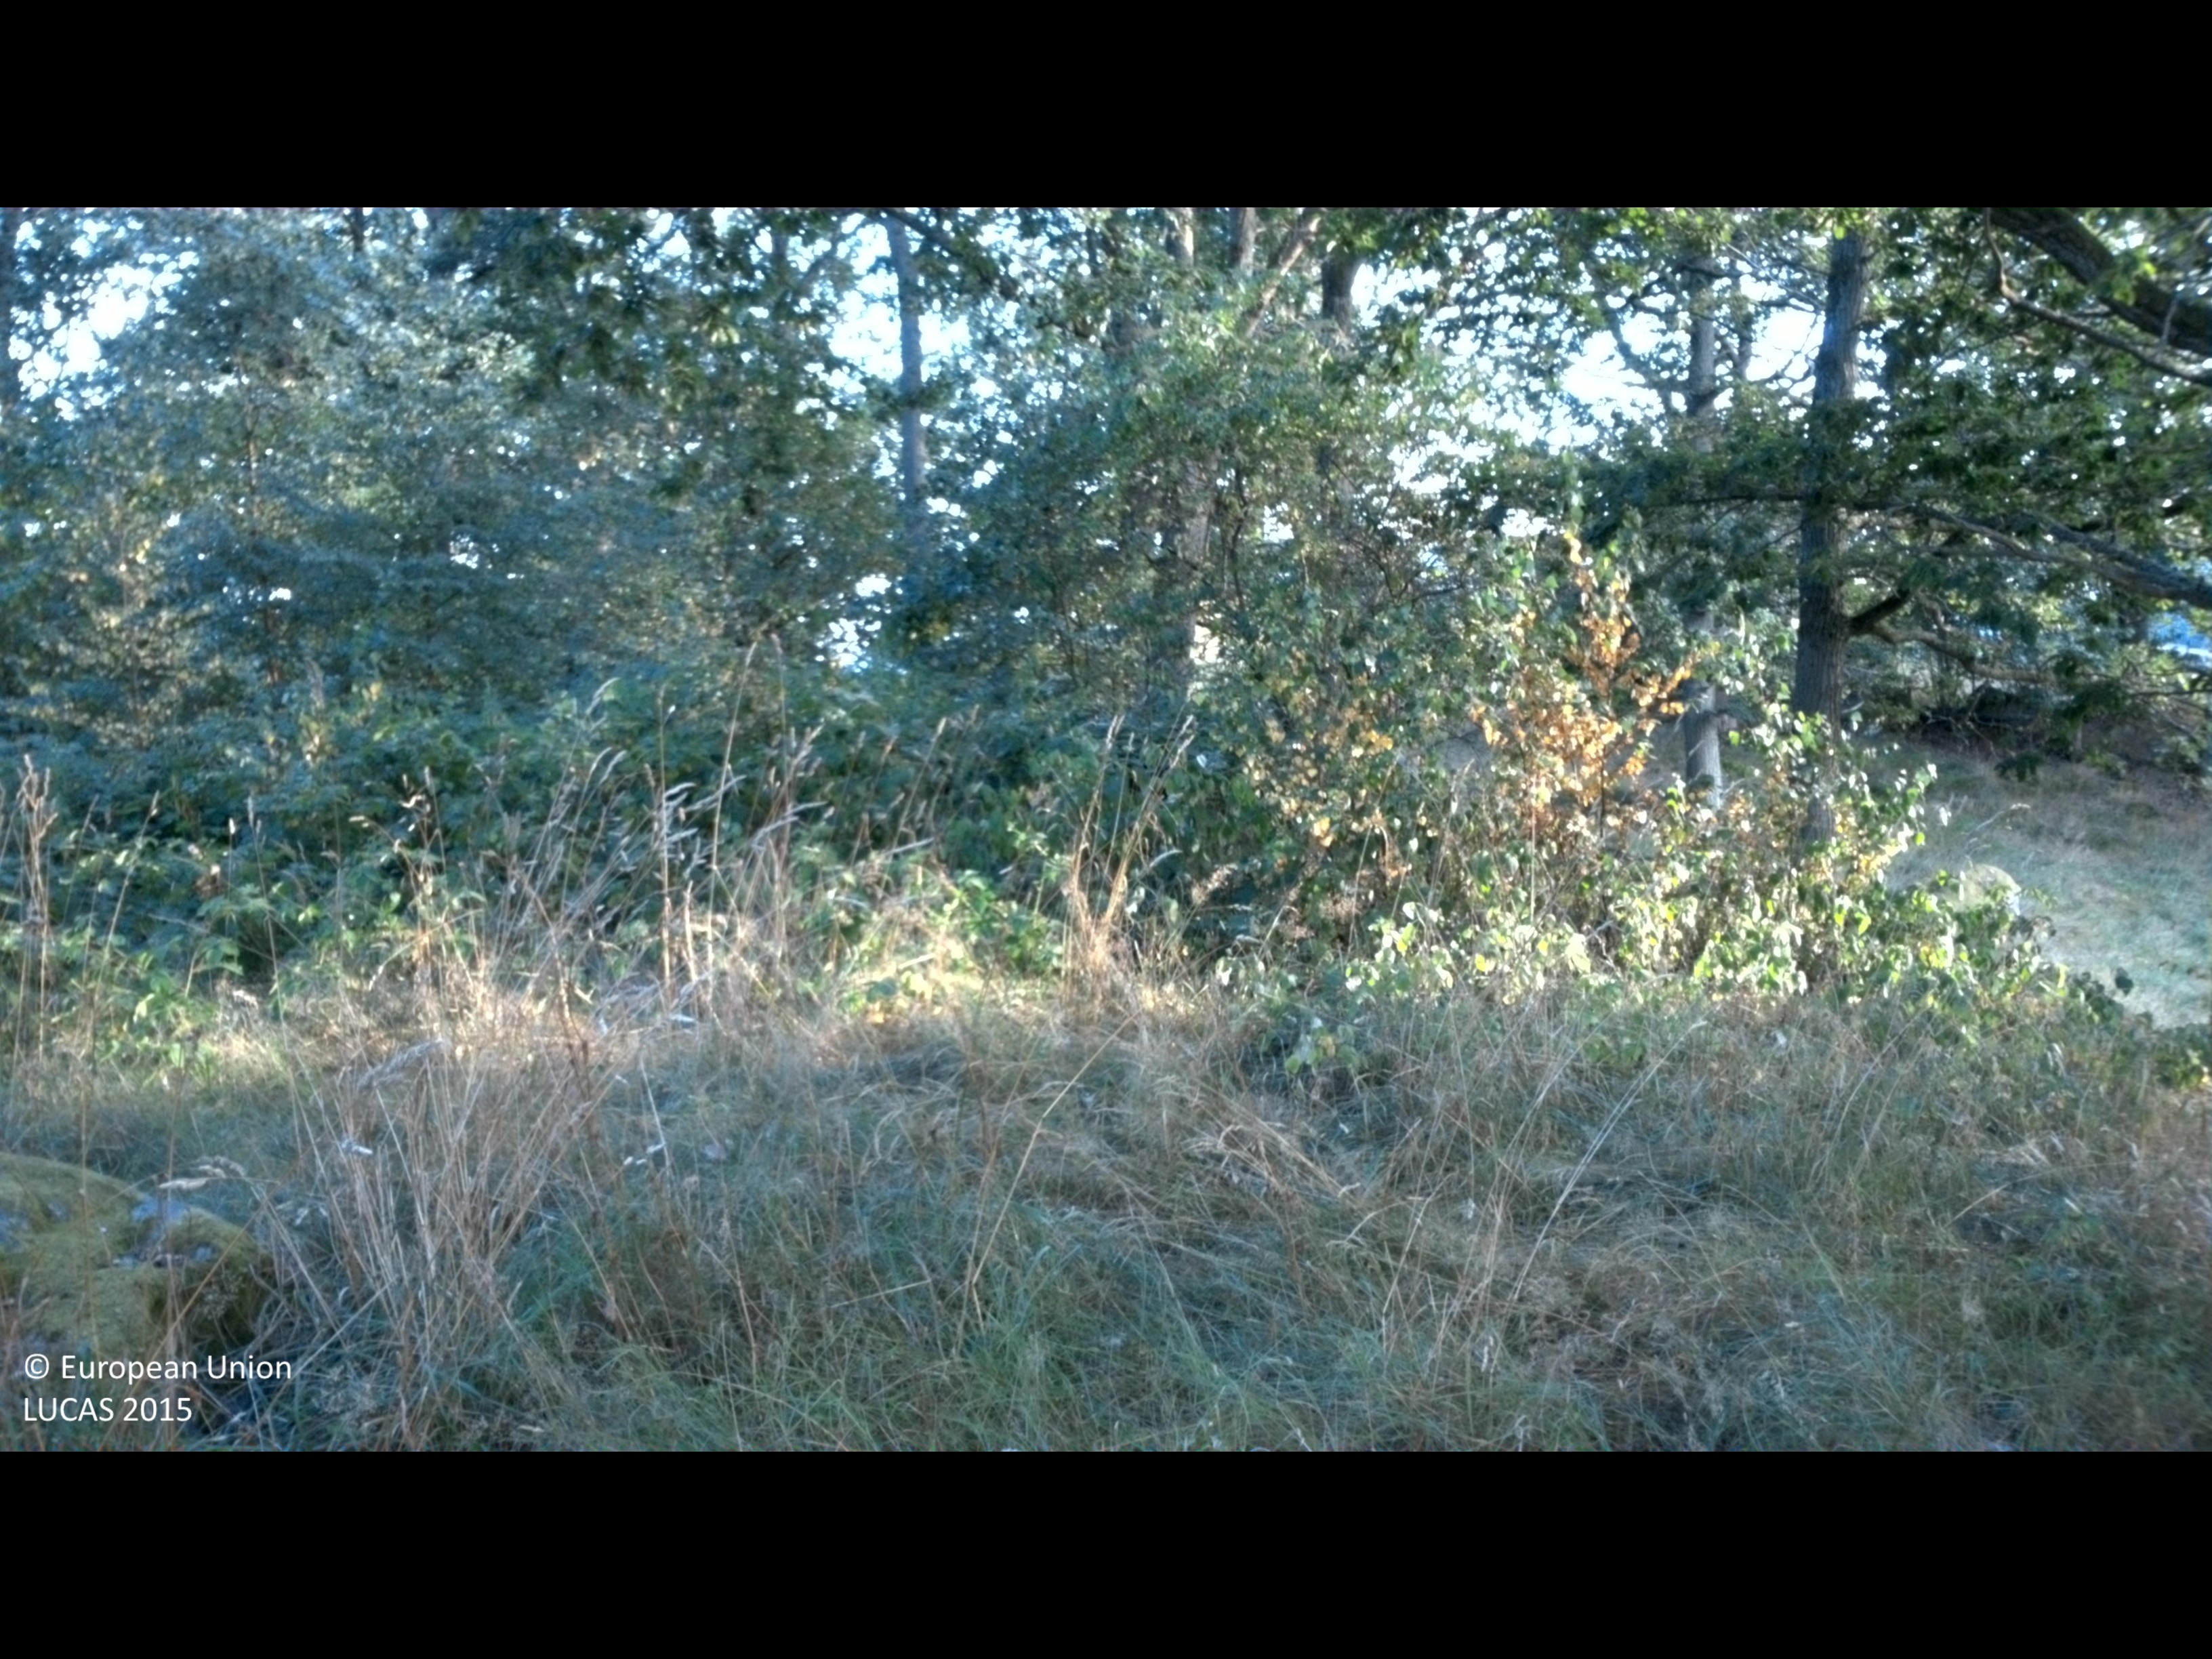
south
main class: Woodland
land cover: Broadleaved woodland
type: mesophytic deciduous forest
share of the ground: 25 - 50 %
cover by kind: herbaceous plants 50 %, broadleaved forest trees 40 %, shrubs 10 %
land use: Forestry
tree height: > 5 m
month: August
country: SE
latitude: 56.2316
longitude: 14.5955
